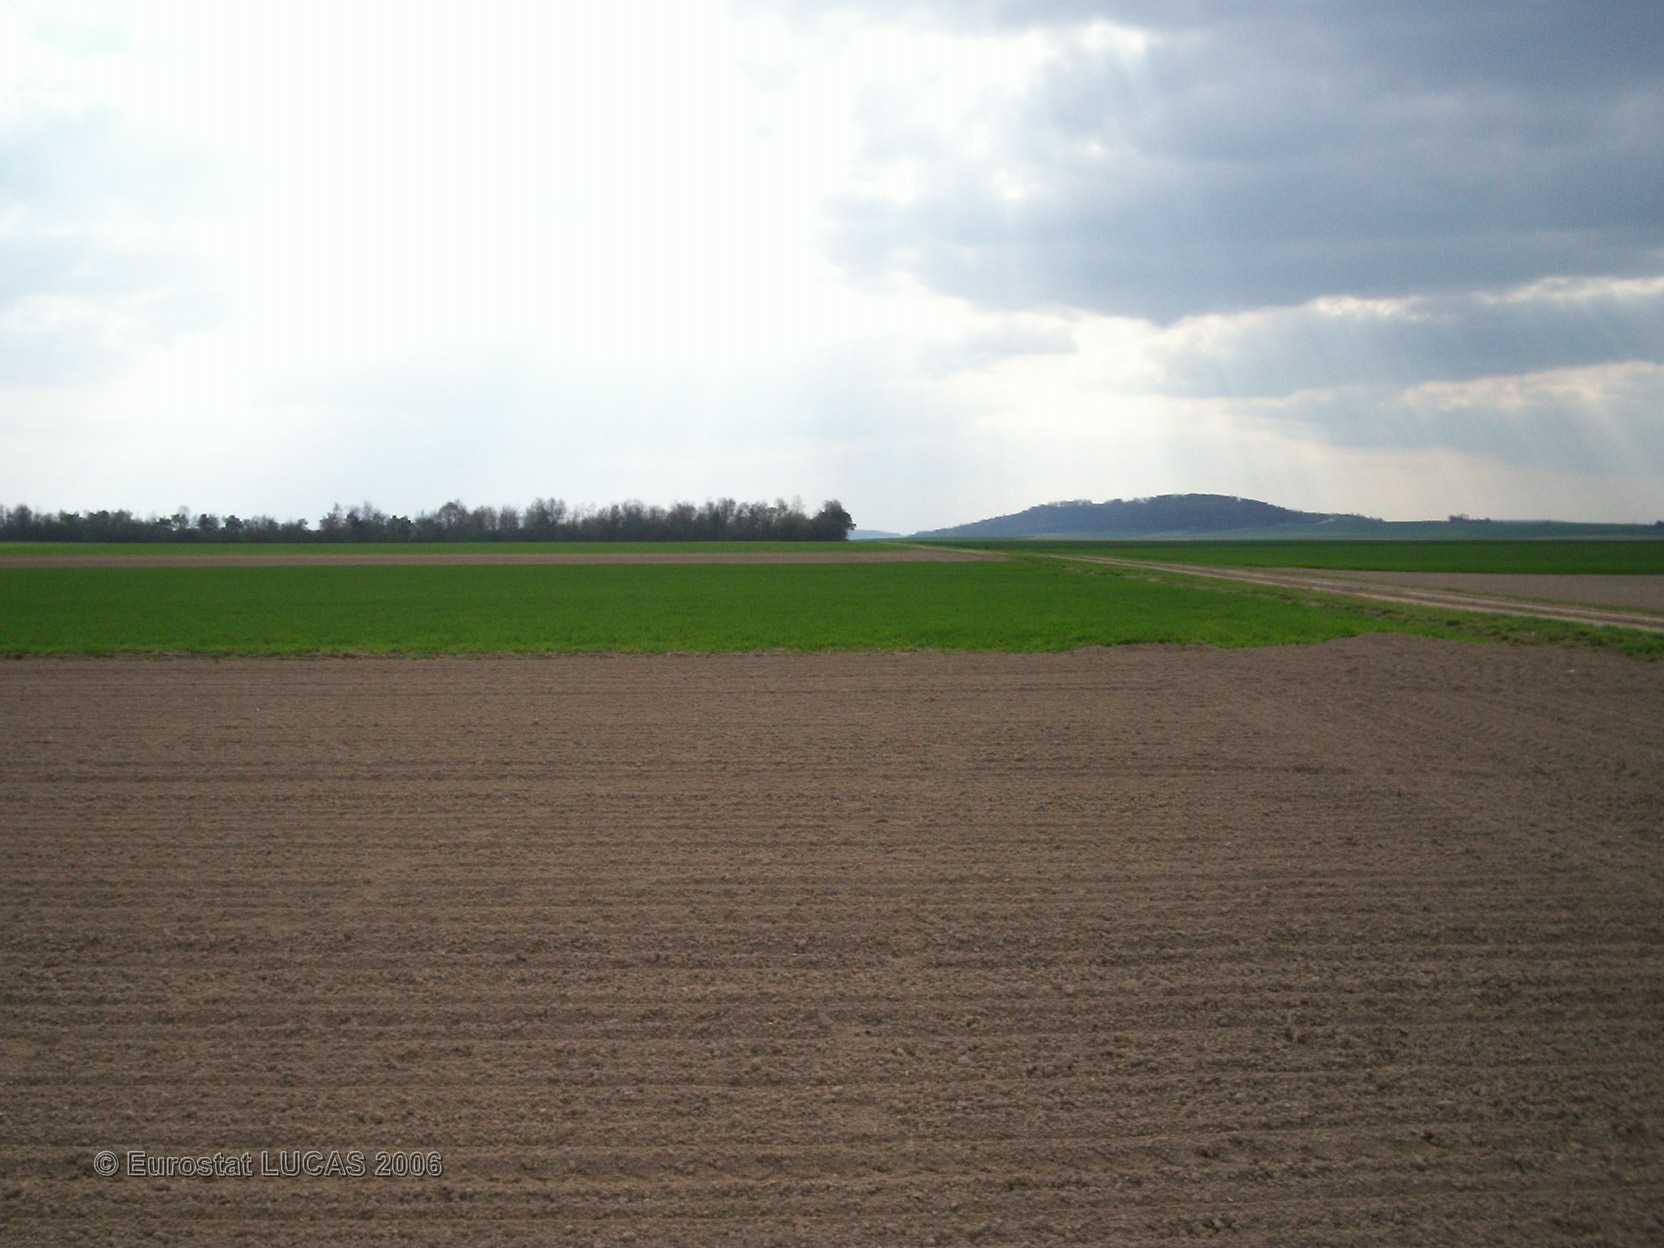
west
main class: Cropland
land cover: Sugar beet
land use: Agriculture (excluding fallow land and kitchen gardens)
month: April
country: FR
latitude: 48.7785
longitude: 3.9394
